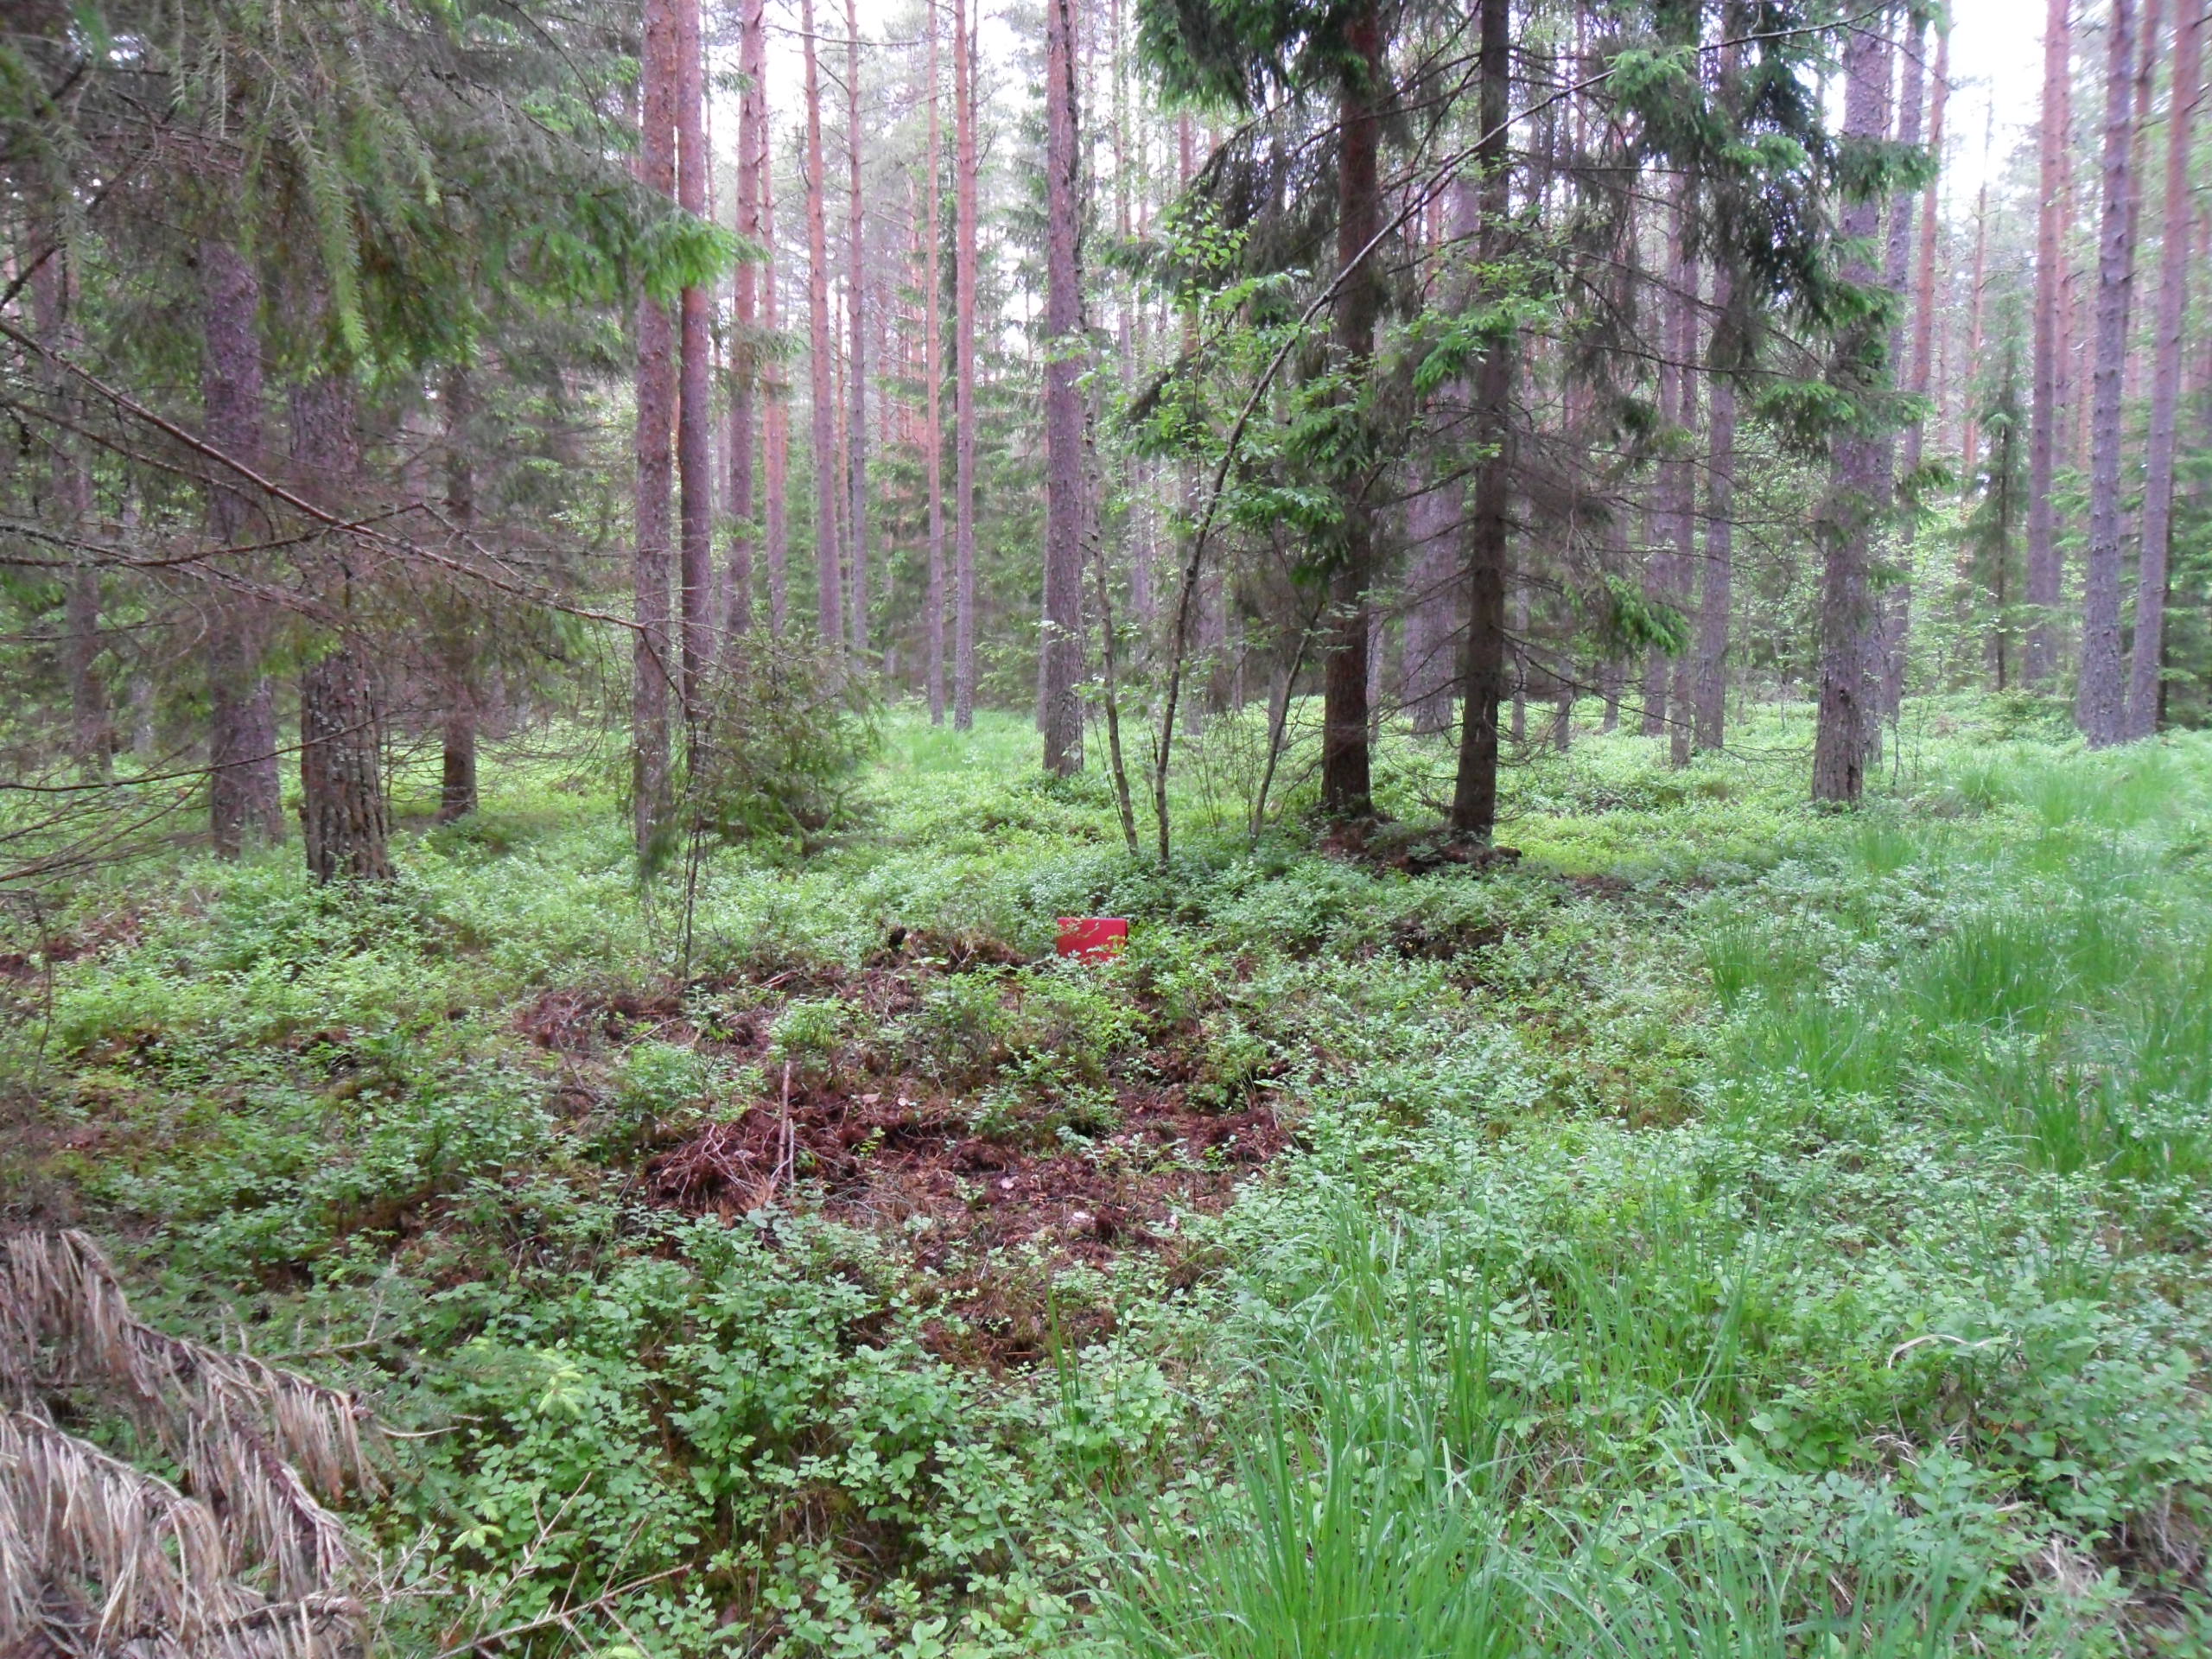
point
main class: Woodland
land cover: Other coniferous woodland
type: hemiboreal forest and nemoral coniferous forest and mixed broadleaved-coniferous forest
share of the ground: > 75 %
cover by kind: coniferous forest trees 70 %, broadleaved forest trees 15 %, herbaceous plants 15 %
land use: Forestry
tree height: > 5 m
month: June
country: LV
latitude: 57.2223
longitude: 22.0207
